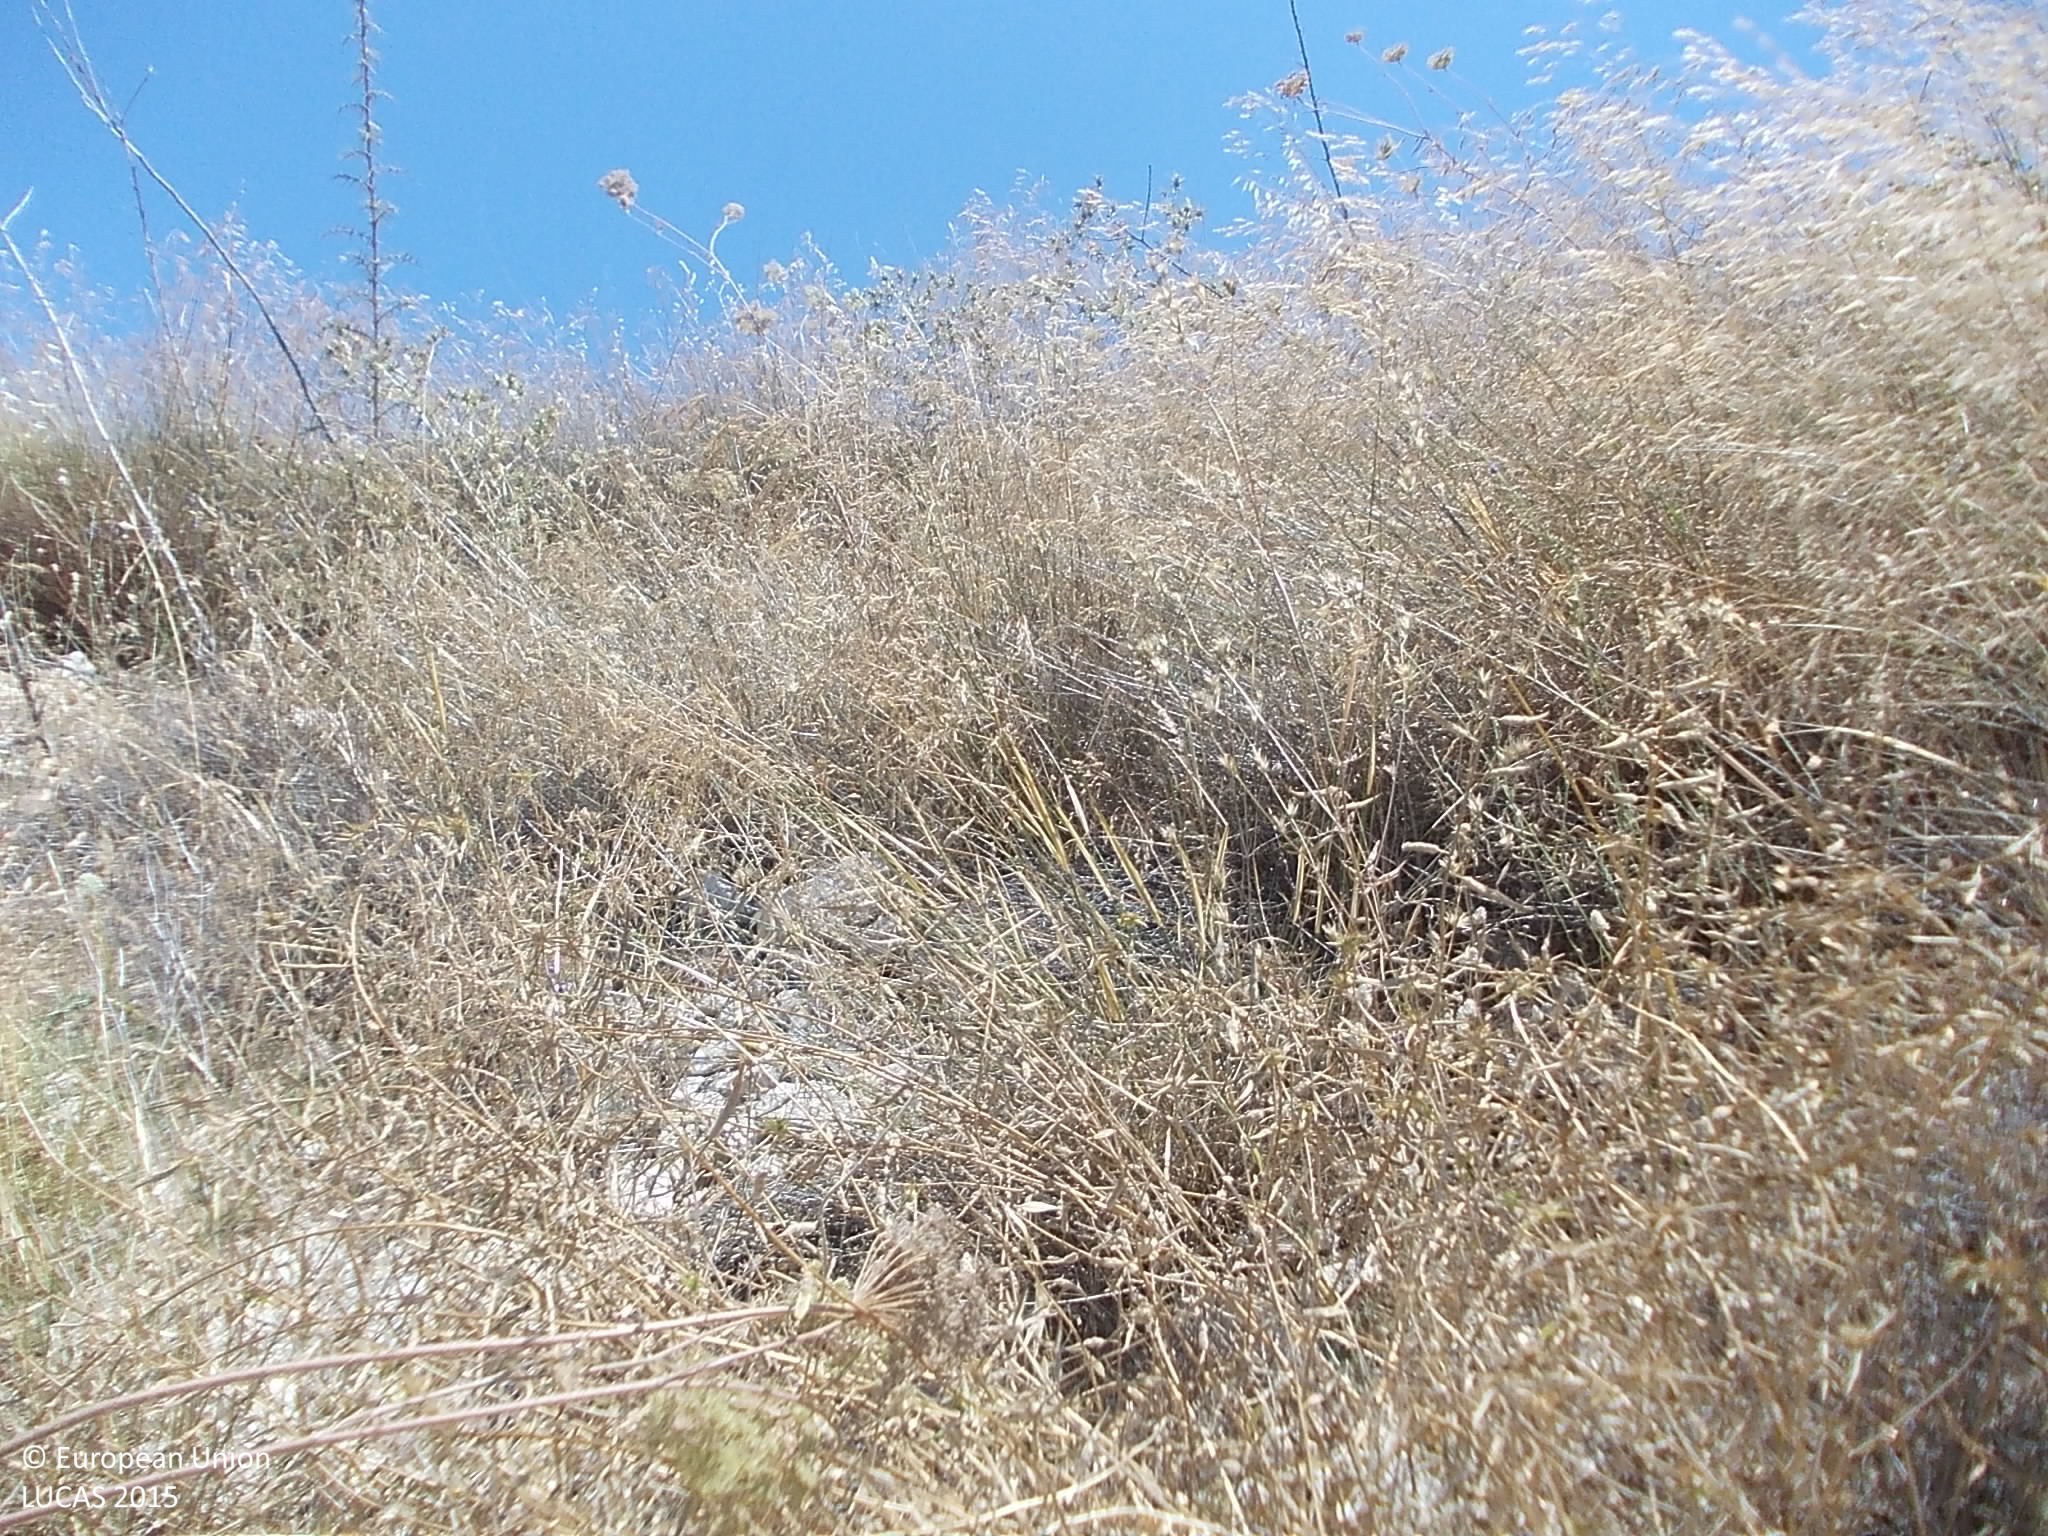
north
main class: Grassland
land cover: Grassland with sparse tree/shrub cover
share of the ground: > 75 %
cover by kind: herbaceous plants 75 %, unconsolidated bare surface 10 %, broadleaved forest trees 5 %, shrubs 5 %, consolidated bare surface 5 %
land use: Semi-natural and natural areas not in use
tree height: < 5 m
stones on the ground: 25 - 50 %
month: July
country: CY
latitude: 34.8238
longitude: 32.7353
